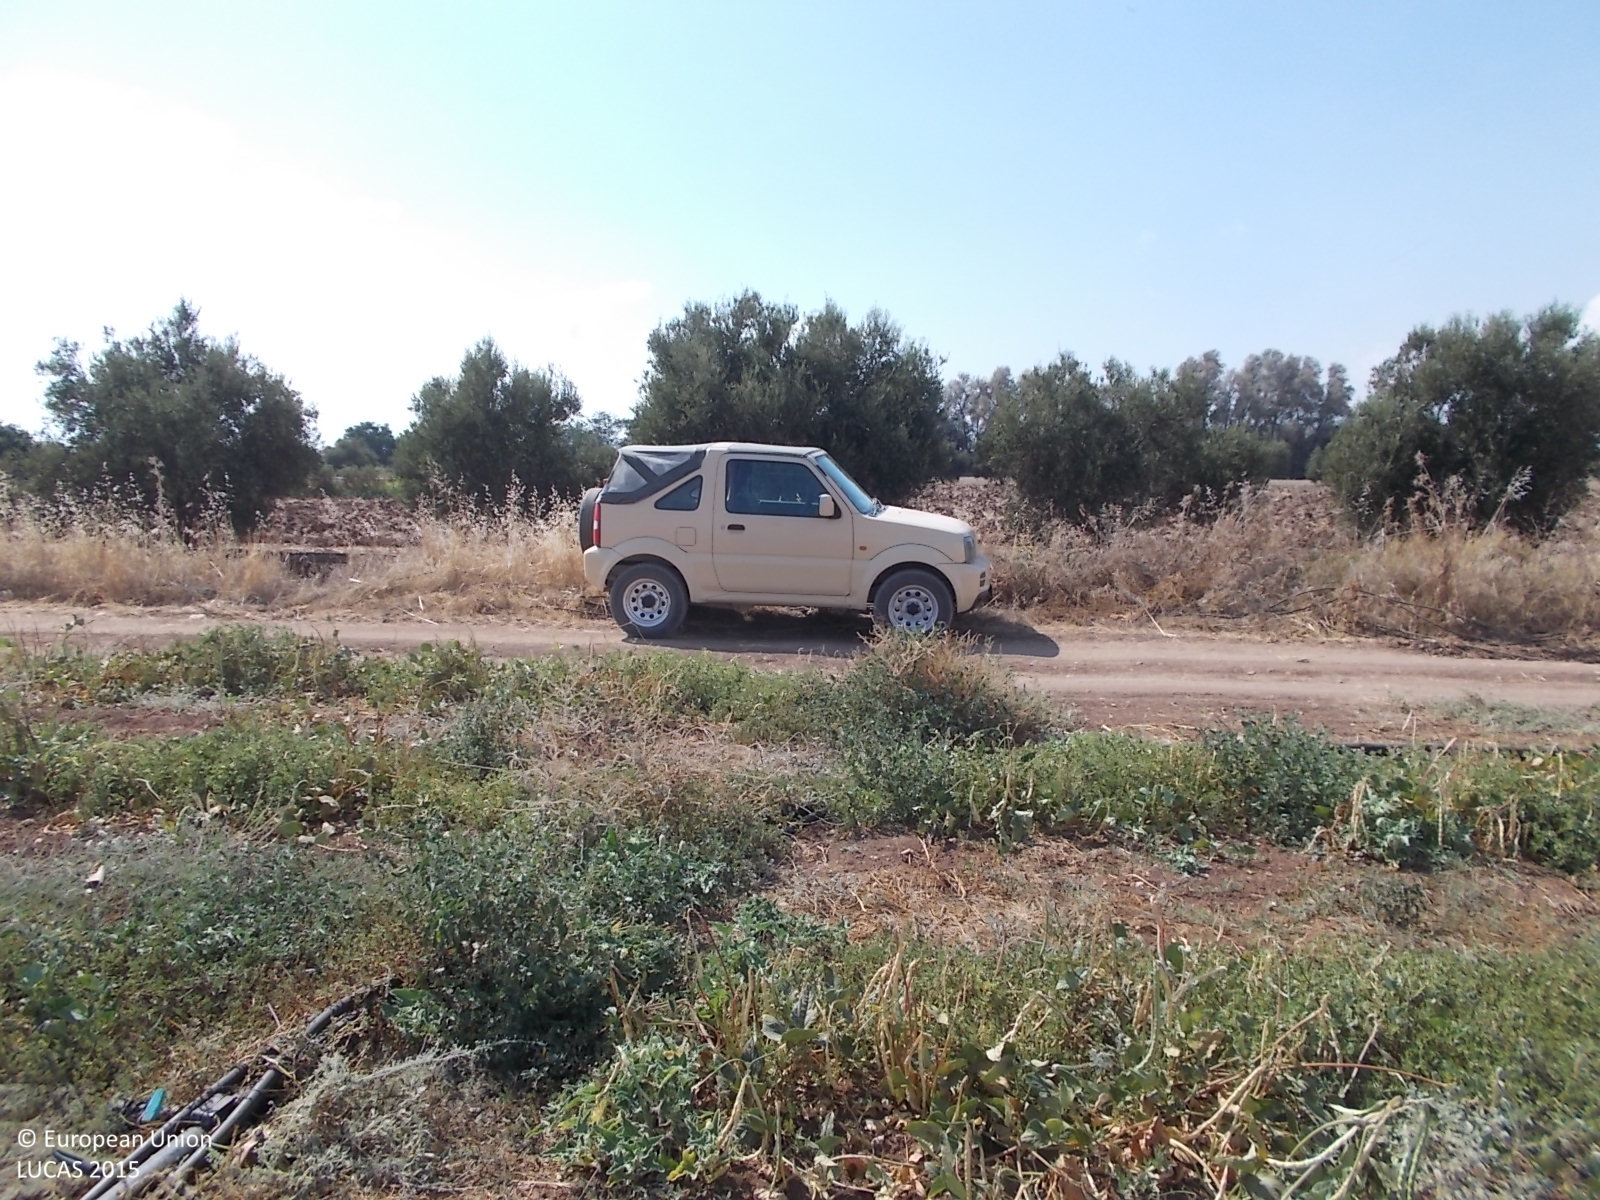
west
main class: Cropland
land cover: Dry pulses
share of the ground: 25 - 50 %
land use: Agriculture (excluding fallow land and kitchen gardens)
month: May
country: CY
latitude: 34.7099
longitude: 32.5177
